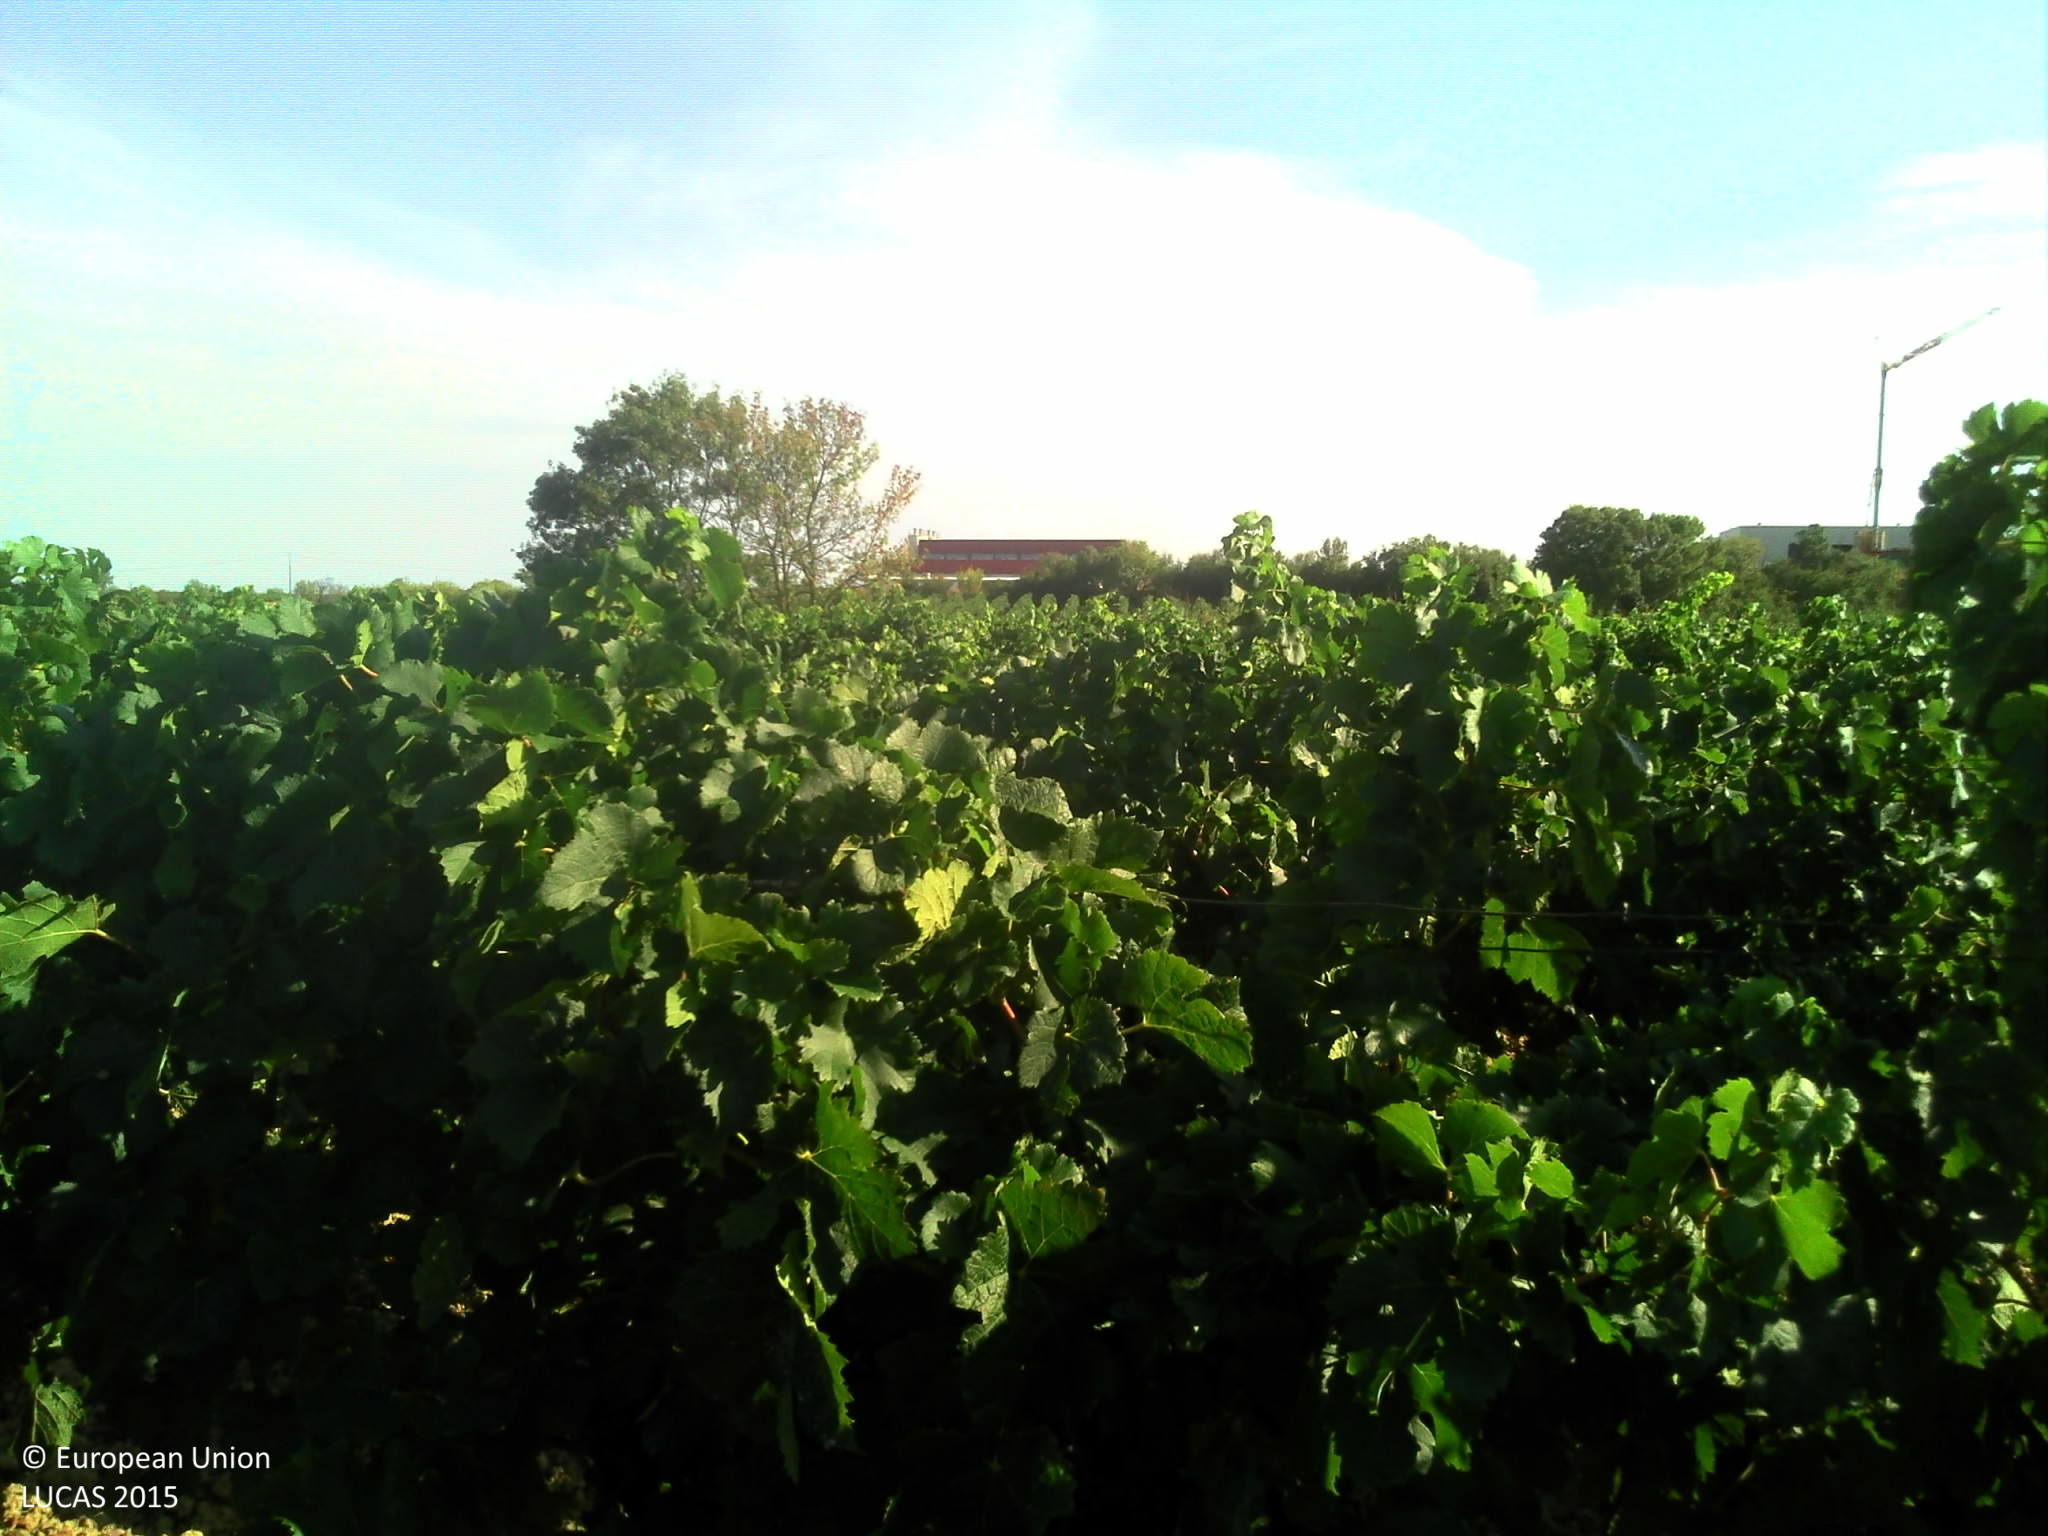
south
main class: Cropland
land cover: Vineyards
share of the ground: 25 - 50 %
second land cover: Other bare soil
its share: > 75 %
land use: Agriculture (excluding fallow land and kitchen gardens)
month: August
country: FR
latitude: 43.3971
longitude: 3.3794
